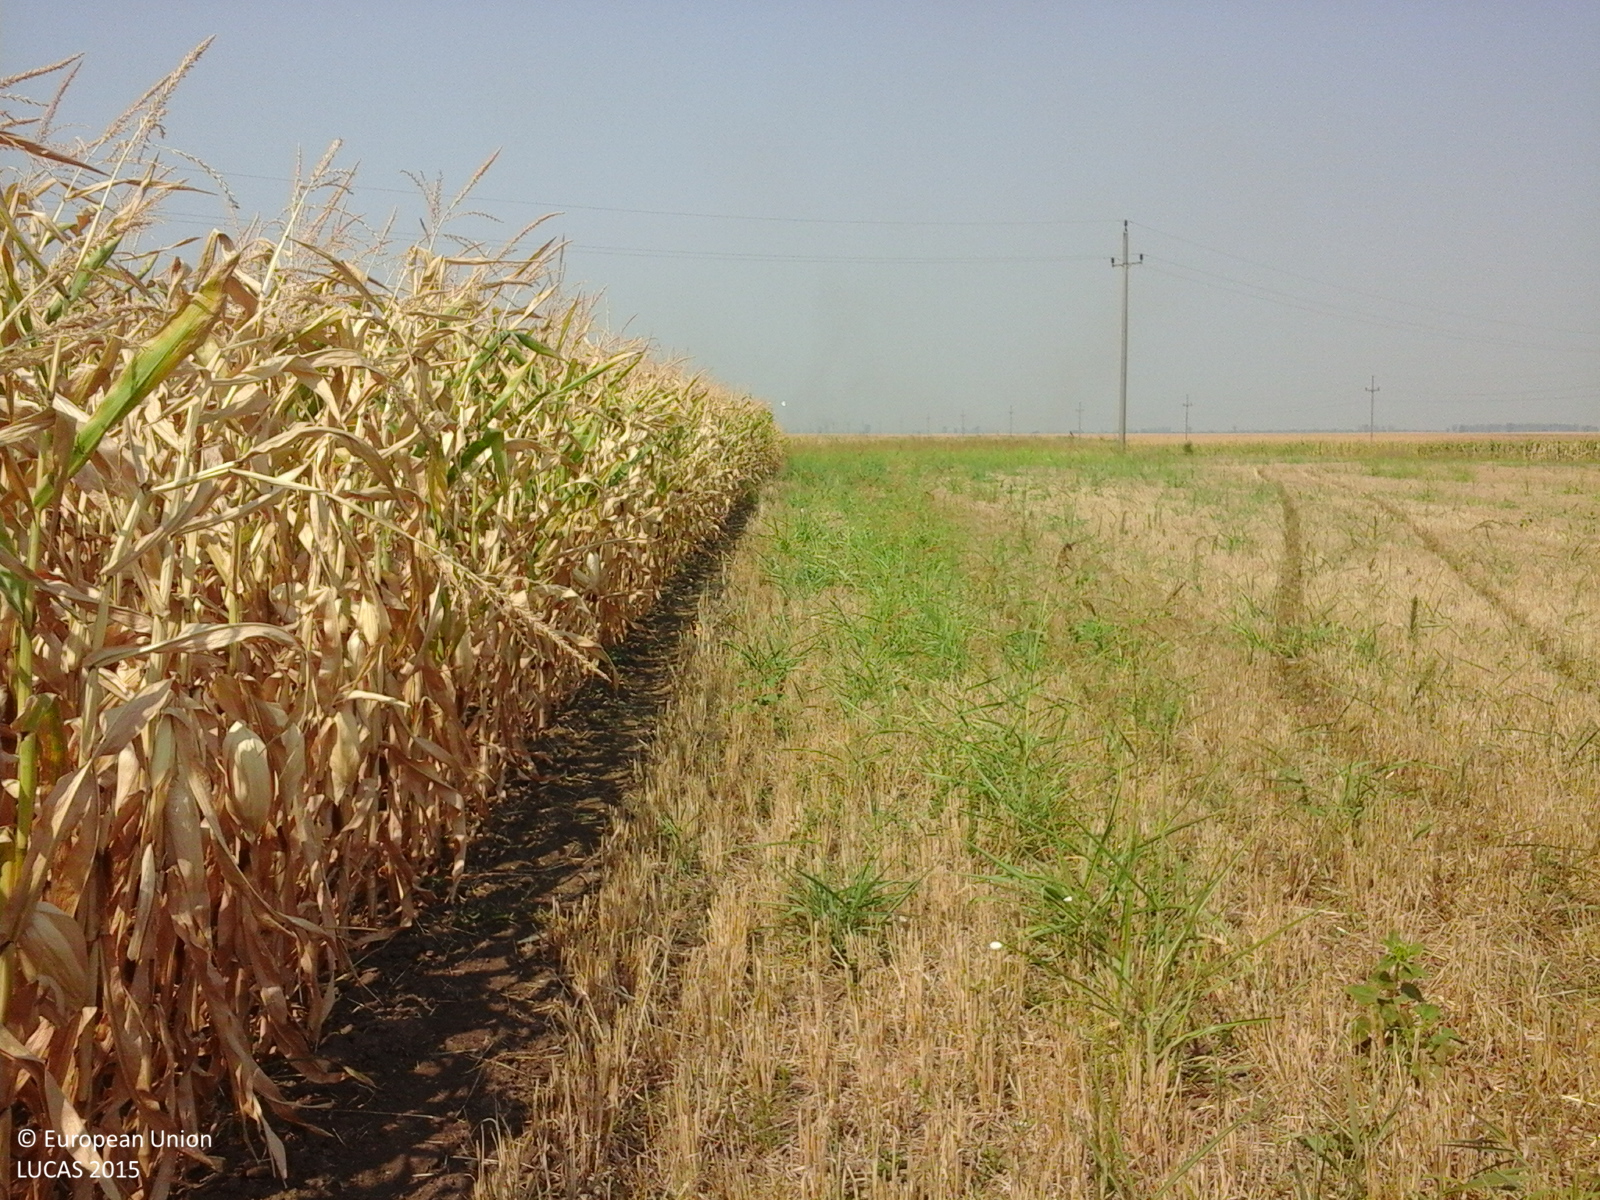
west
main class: Cropland
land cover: Maize
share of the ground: > 75 %
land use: Agriculture (excluding fallow land and kitchen gardens)
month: August
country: RO
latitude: 43.8979
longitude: 23.2533
